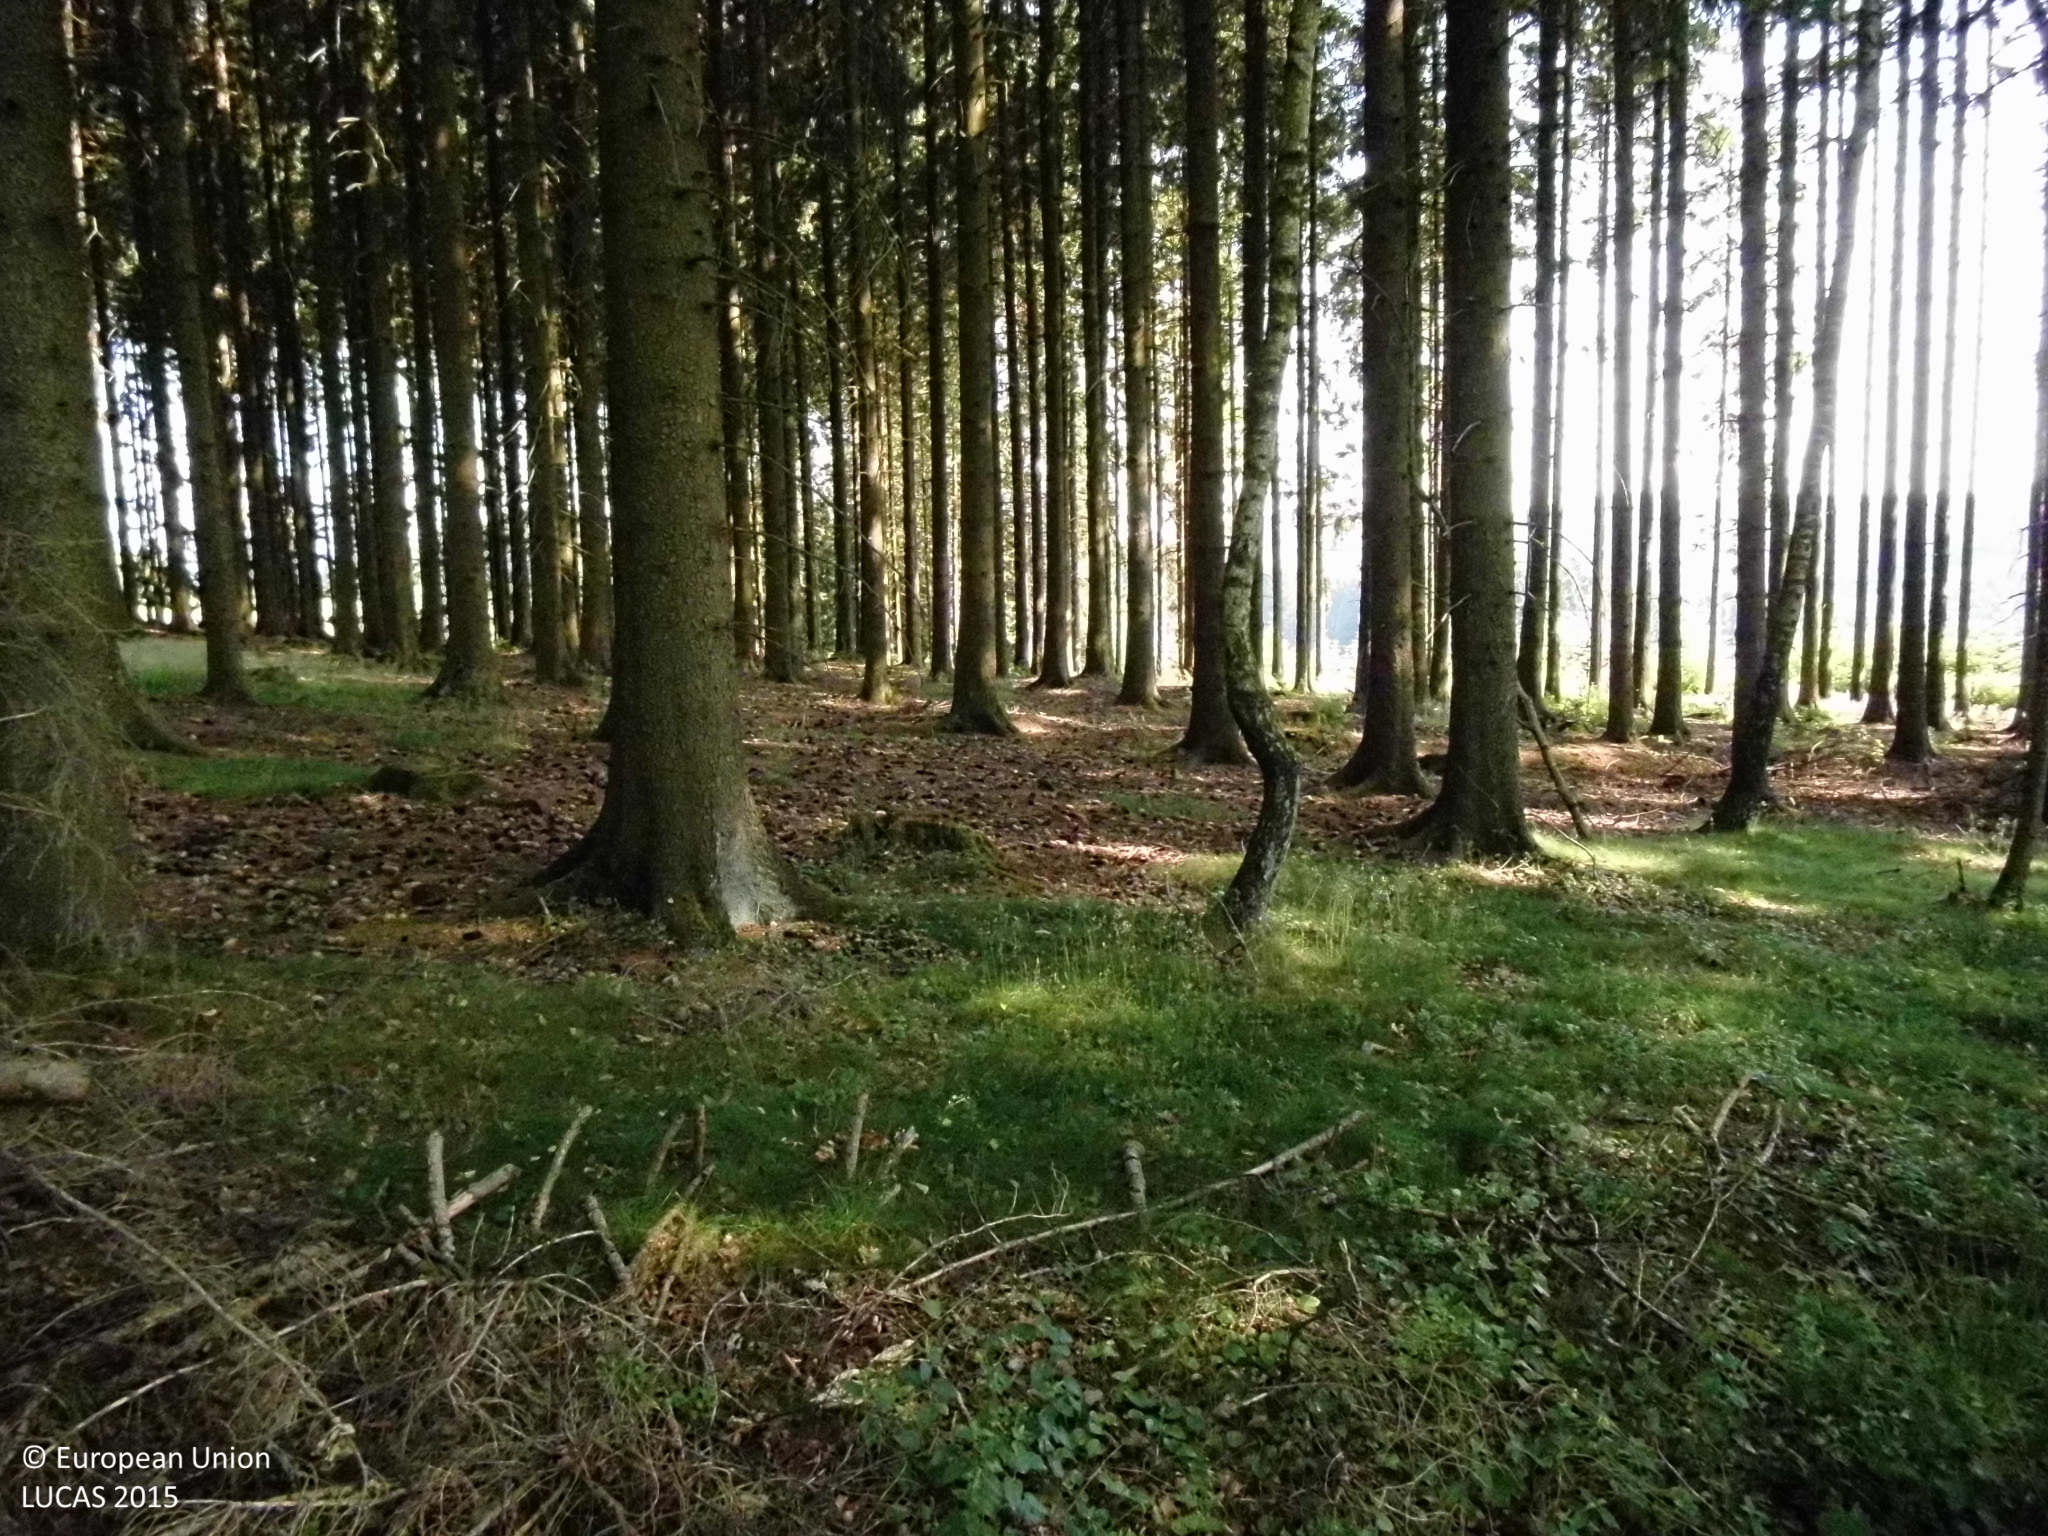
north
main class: Woodland
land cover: Broadleaved woodland
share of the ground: > 75 %
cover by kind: broadleaved forest trees 95 %, herbaceous plants 5 %
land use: Forestry
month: July
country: DE
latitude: 51.2455
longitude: 7.9804
